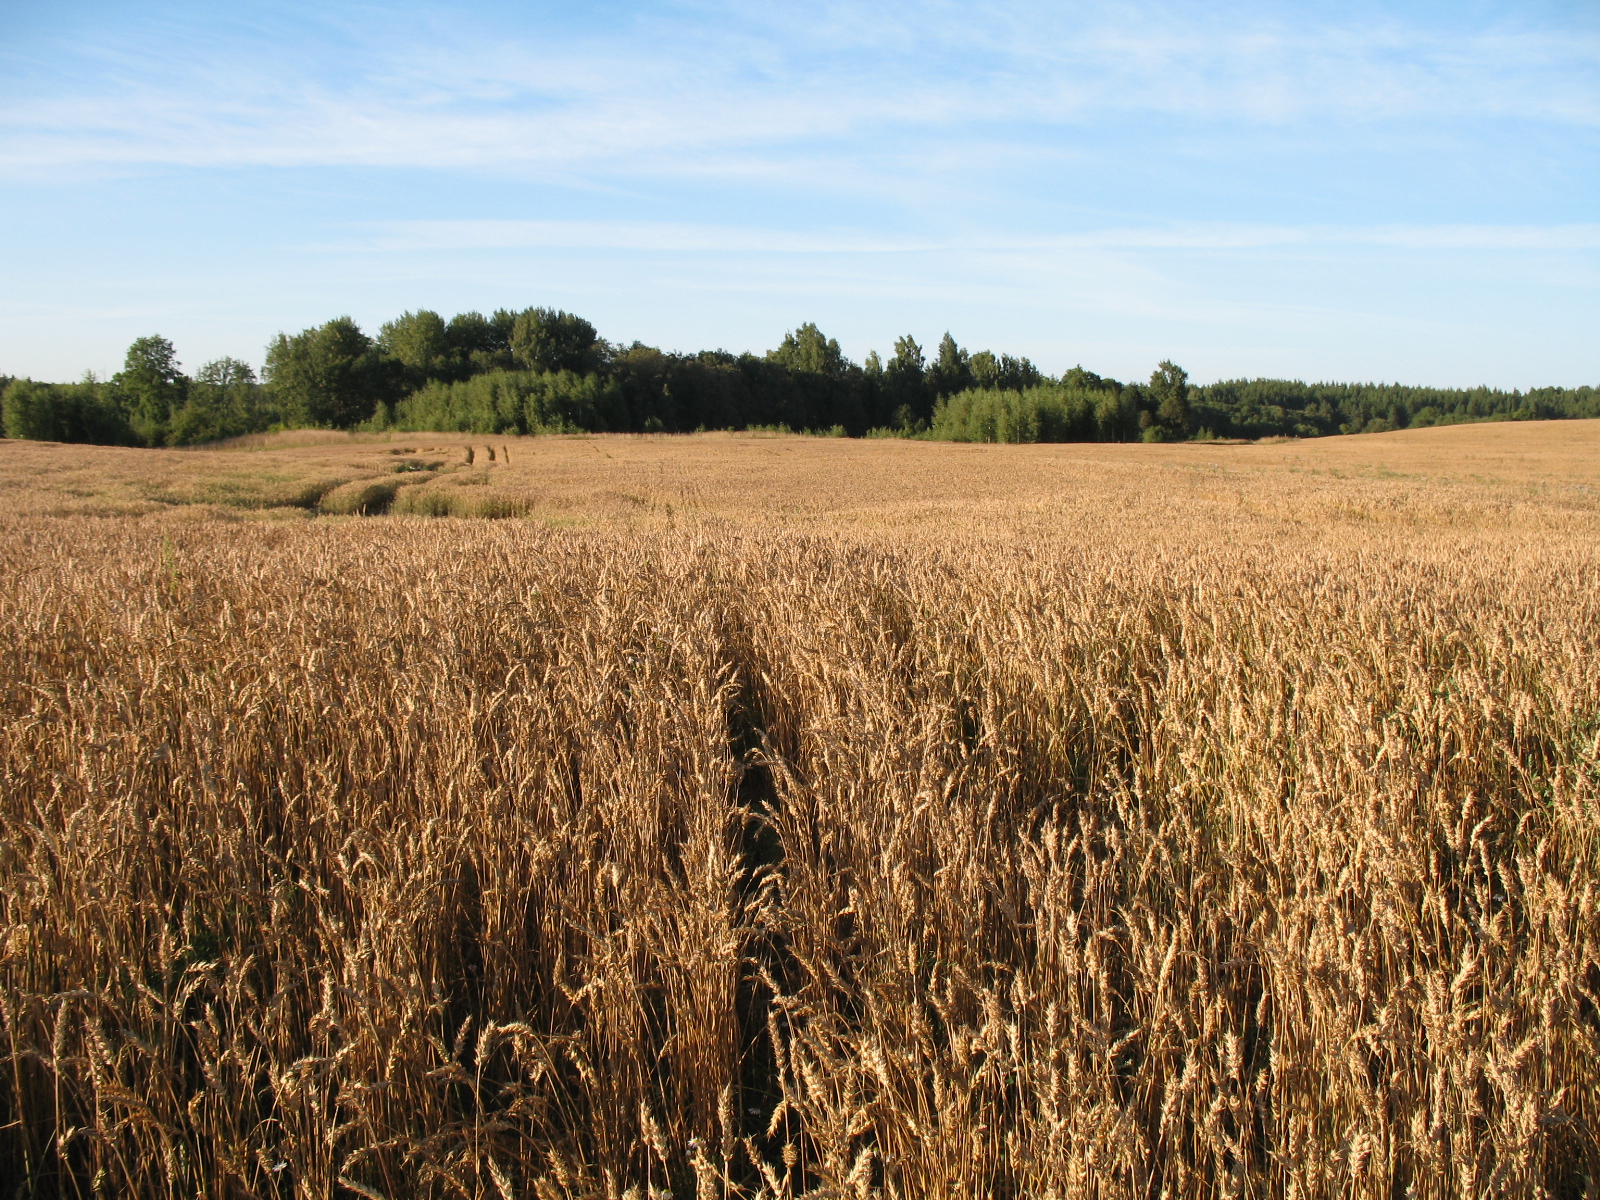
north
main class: Cropland
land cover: Common wheat
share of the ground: > 75 %
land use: Agriculture (excluding fallow land and kitchen gardens)
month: August
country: LV
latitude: 56.5653
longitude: 25.5984
